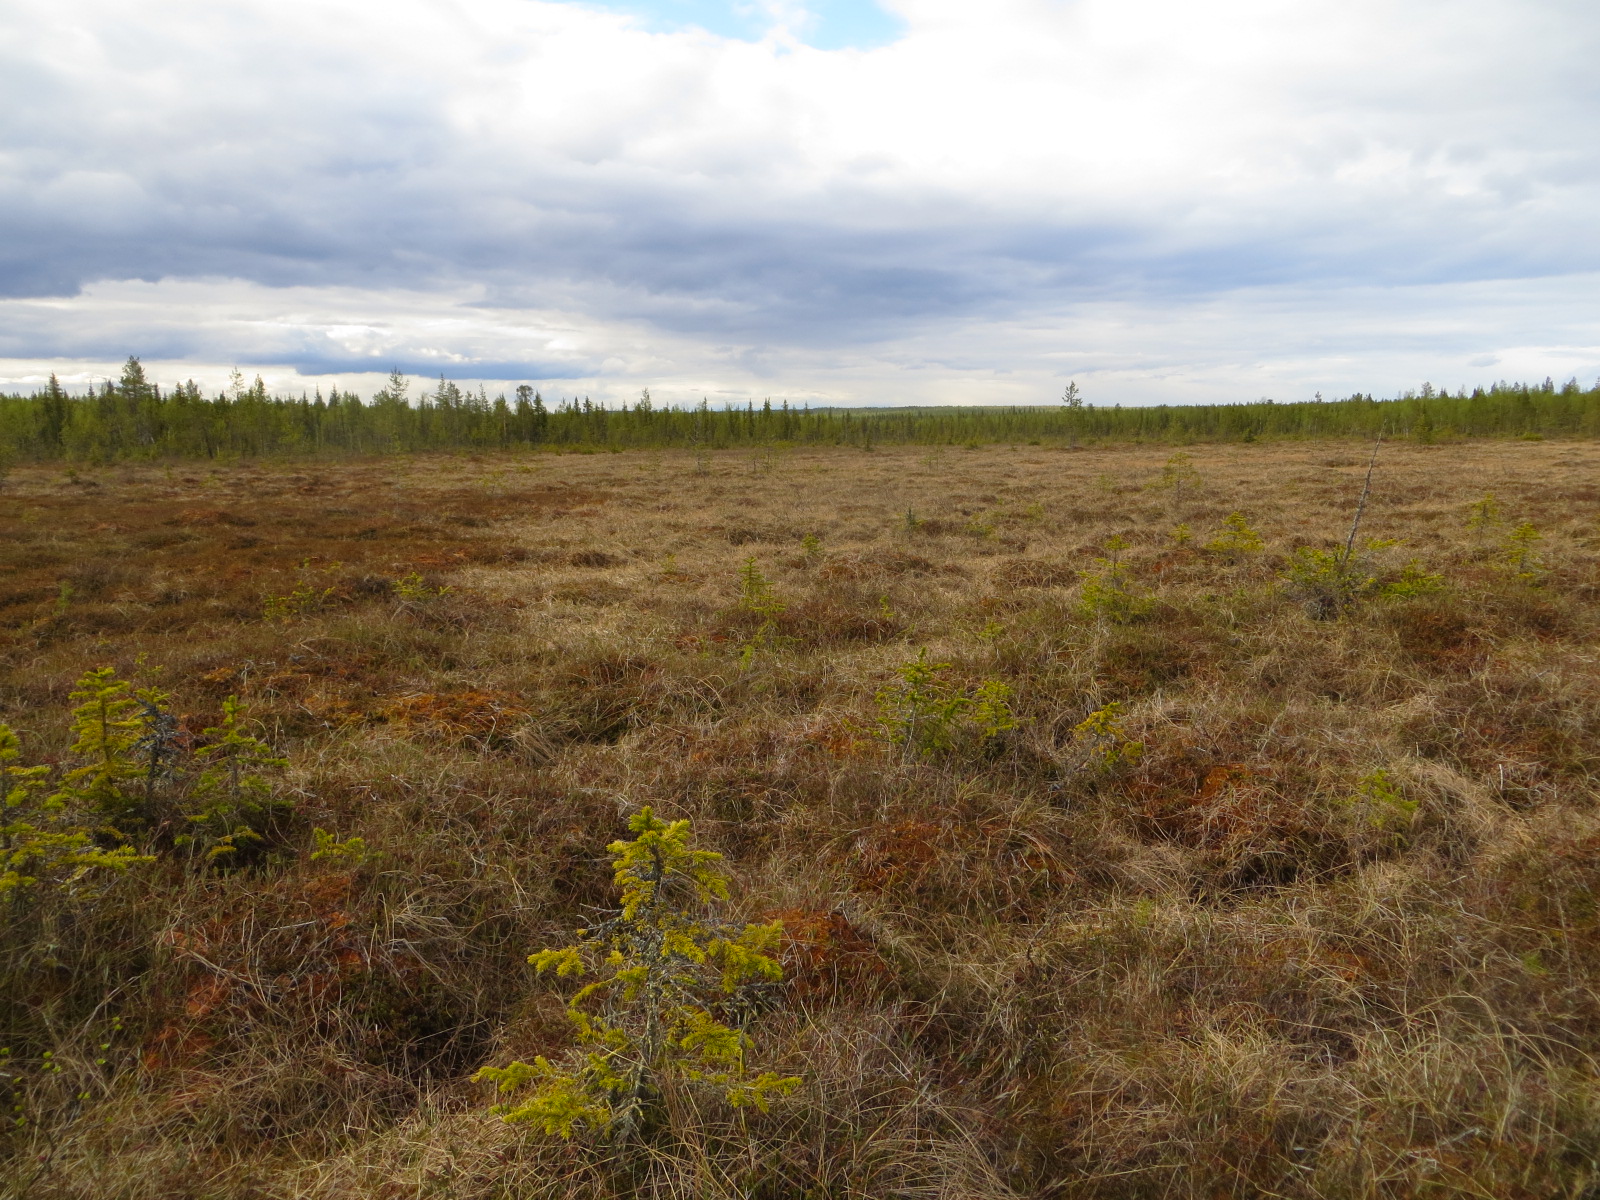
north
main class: Woodland
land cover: Pine dominated coniferous woodland
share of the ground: 25 - 50 %
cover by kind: coniferous forest trees 30 %, shrubs 30 %, herbaceous plants 30 %, lichens and mosses 10 %
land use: Semi-natural and natural areas not in use
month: June
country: FI
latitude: 67.1478
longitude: 24.8794
